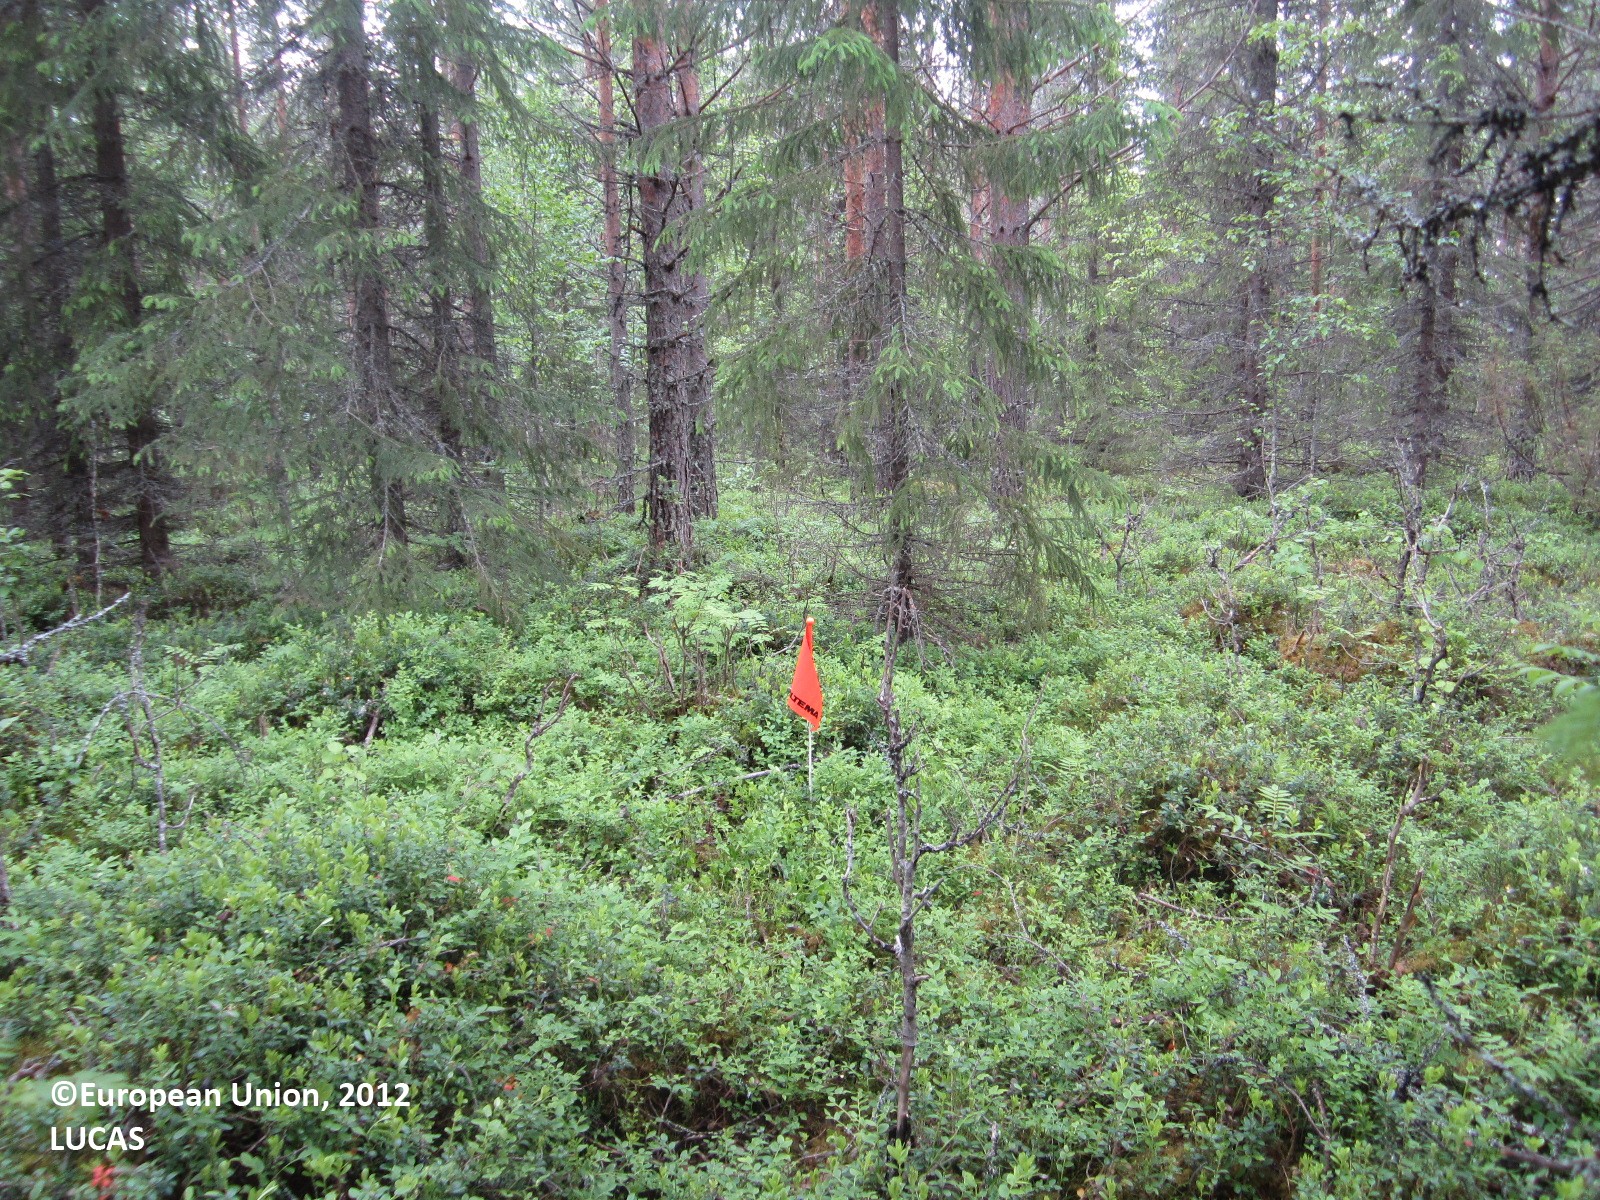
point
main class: Woodland
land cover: Other coniferous woodland
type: boreal forest
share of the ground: > 75 %
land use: Forestry
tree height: > 5 m
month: June
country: FI
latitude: 64.3440
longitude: 29.8327
